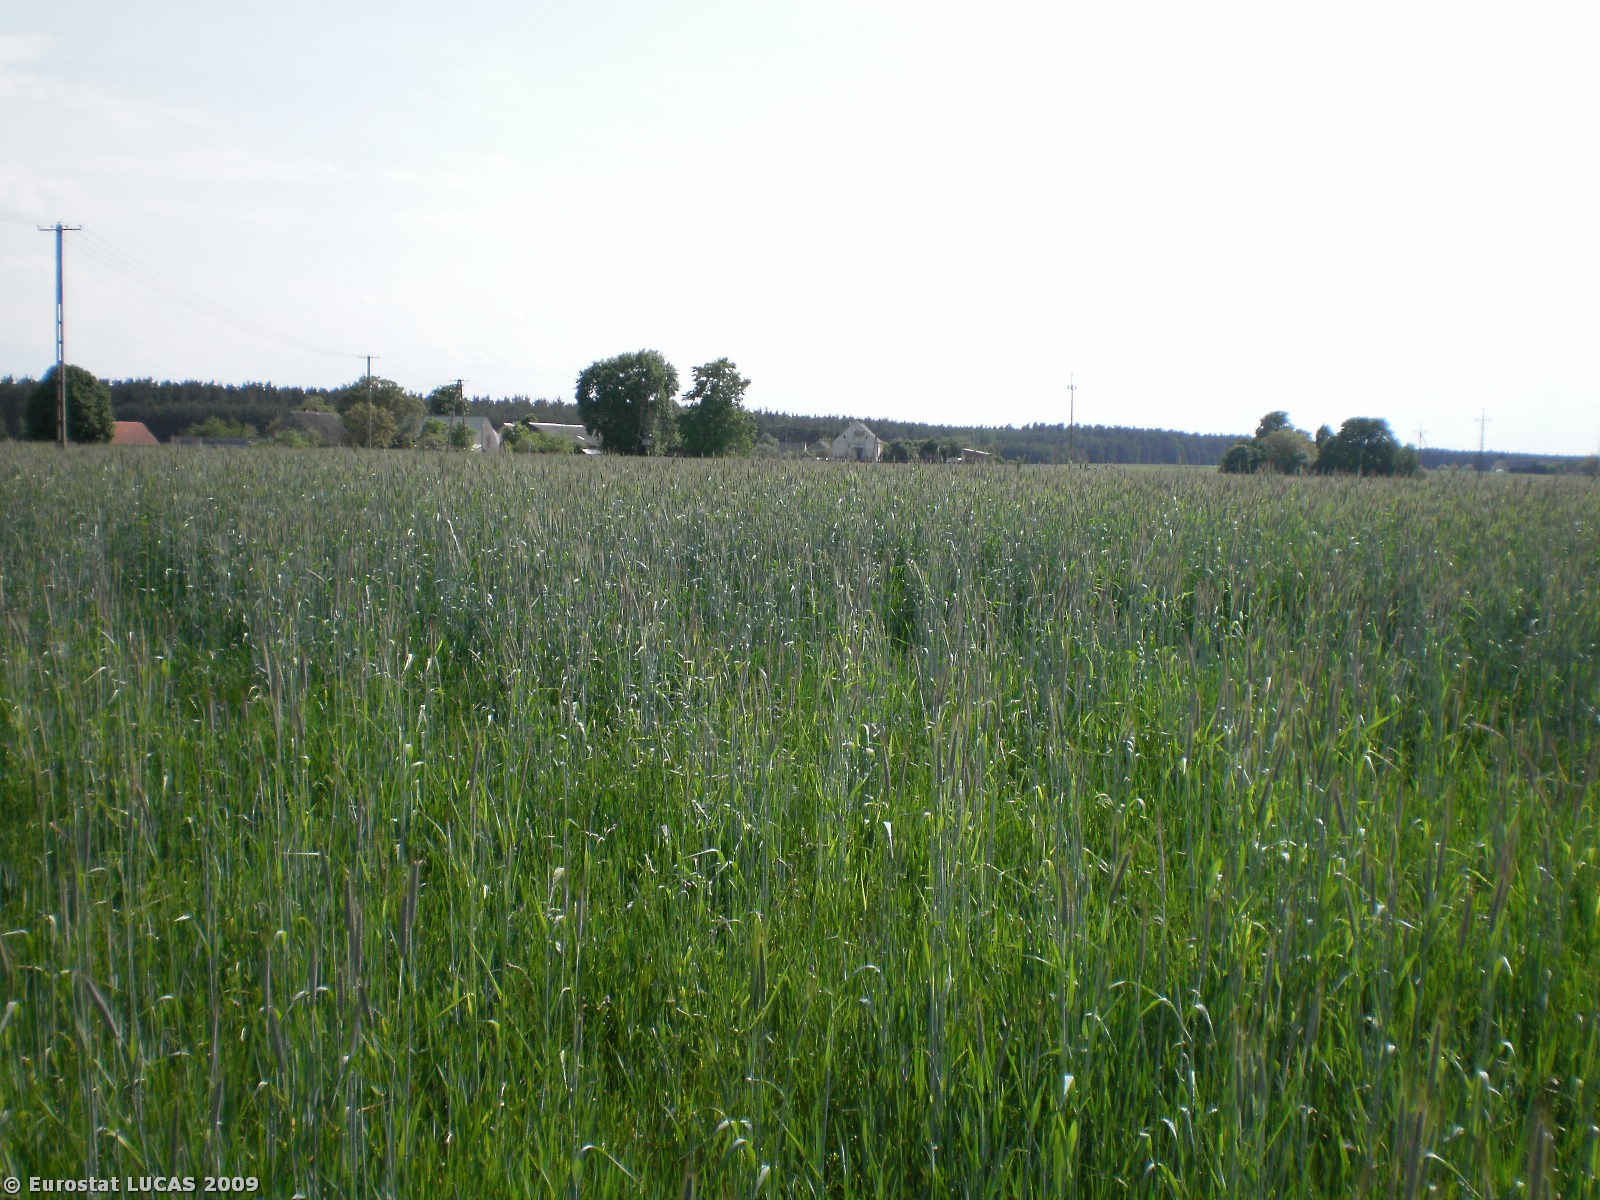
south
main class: Cropland
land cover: Mixed cereals for fodder
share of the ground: > 75 %
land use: Agriculture (excluding fallow land and kitchen gardens)
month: May
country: PL
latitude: 53.5526
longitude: 17.9995
